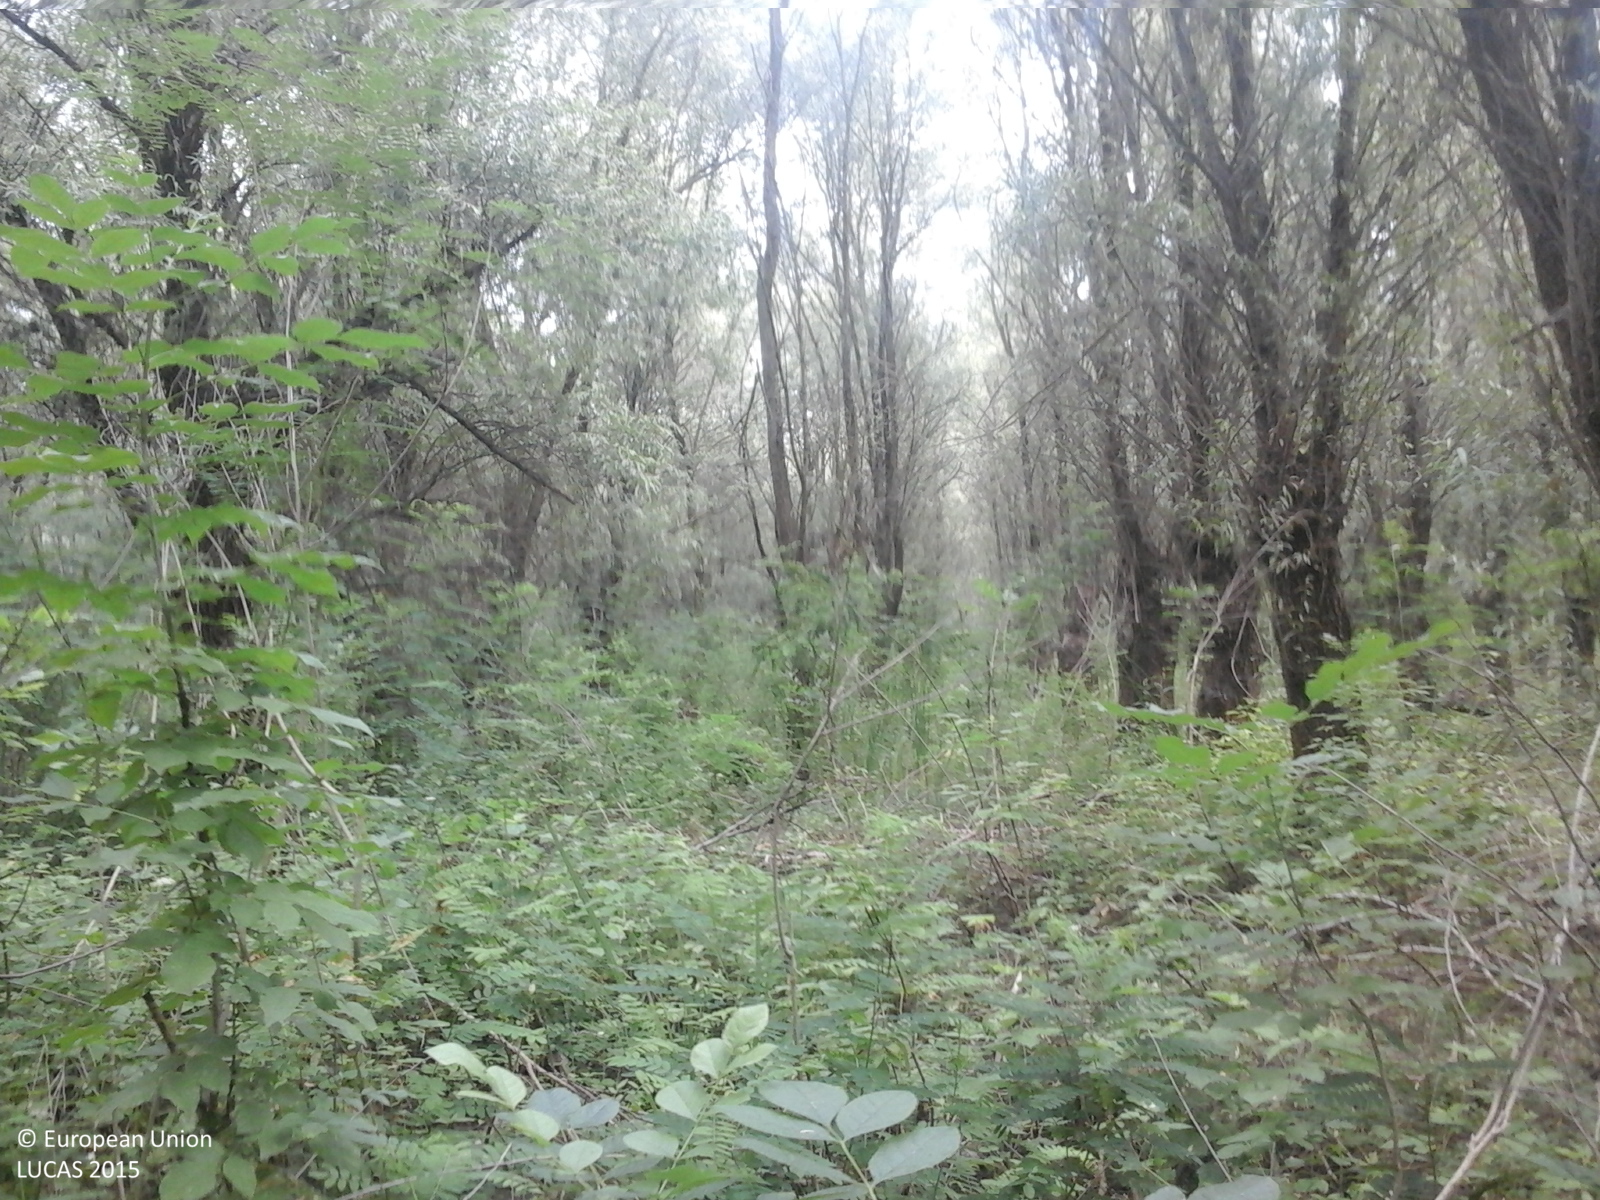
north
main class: Woodland
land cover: Broadleaved woodland
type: floodplain forest
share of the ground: > 75 %
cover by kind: broadleaved forest trees 100 %
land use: Forestry
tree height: > 5 m
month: July
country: RO
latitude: 45.0776
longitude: 28.1437
